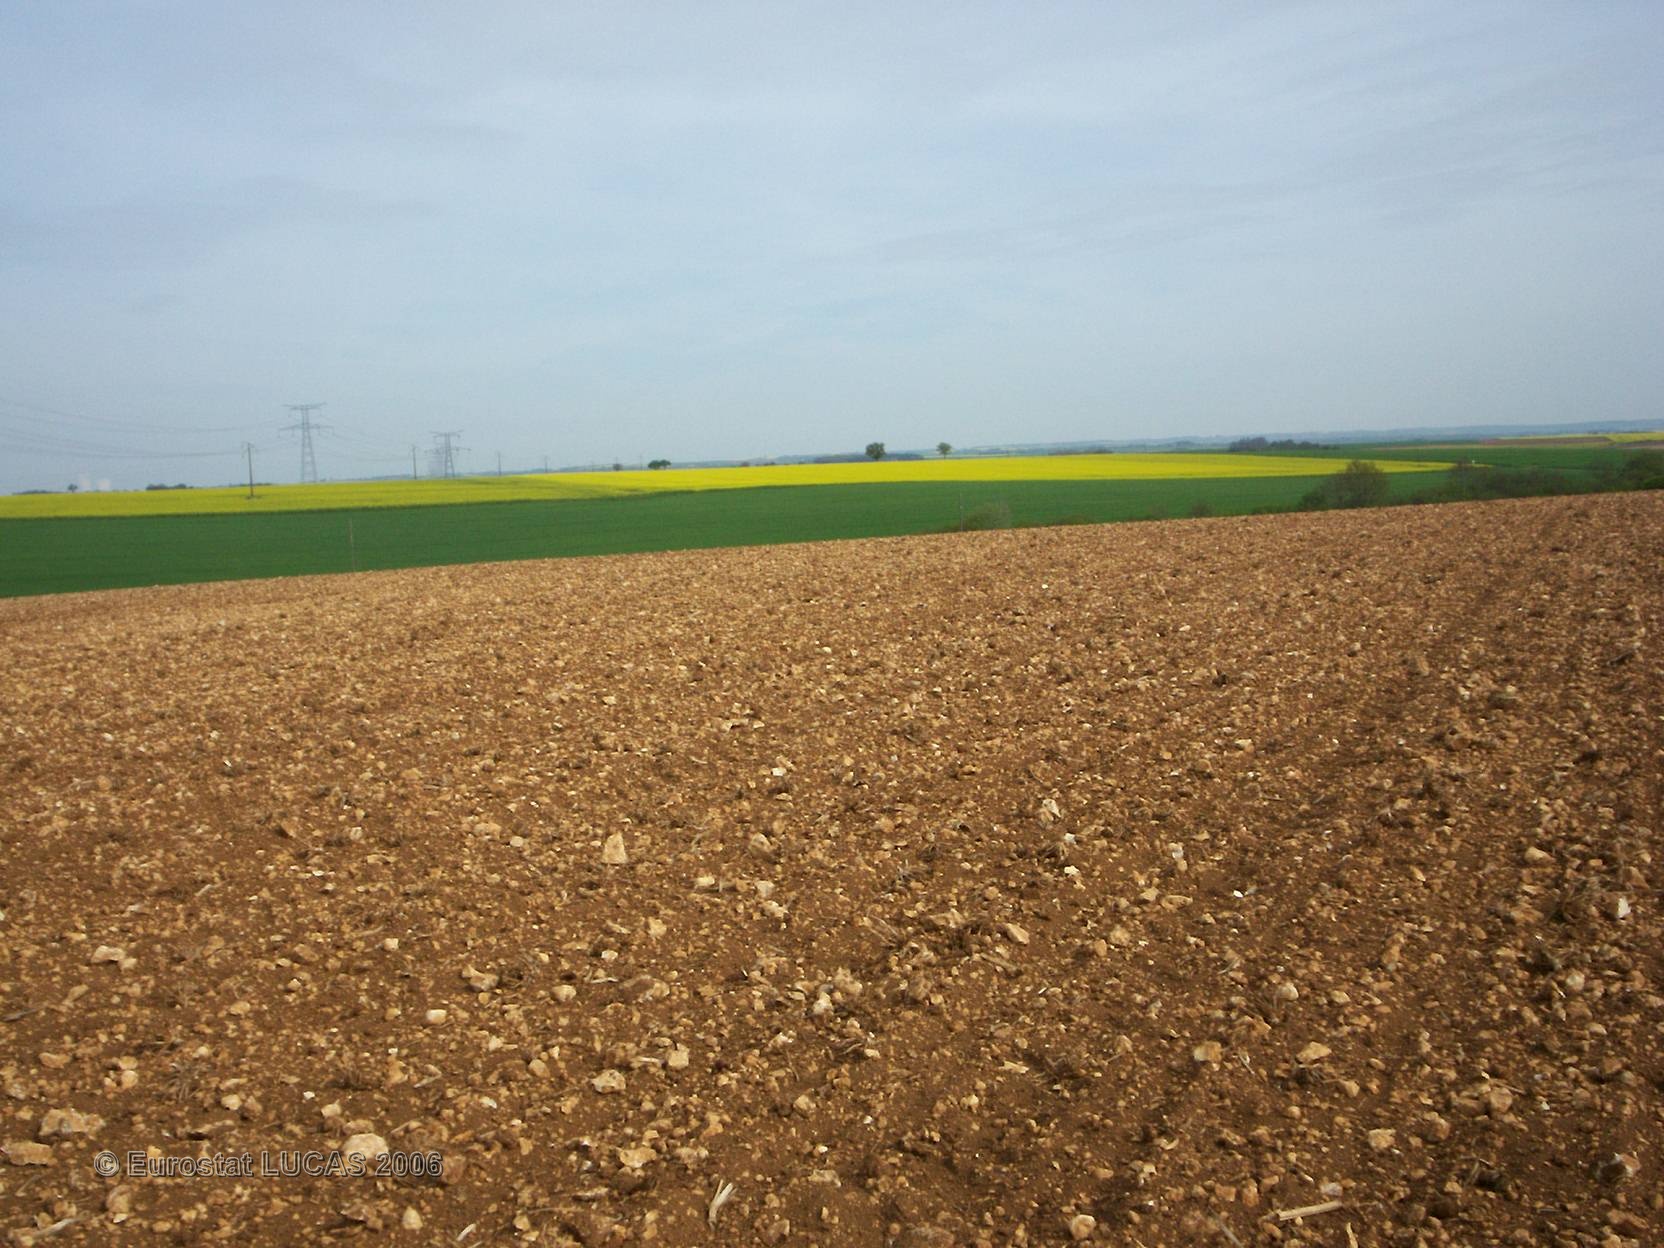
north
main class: Cropland
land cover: Sunflower
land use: Agriculture (excluding fallow land and kitchen gardens)
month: May
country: FR
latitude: 47.3160
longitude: 3.0231
